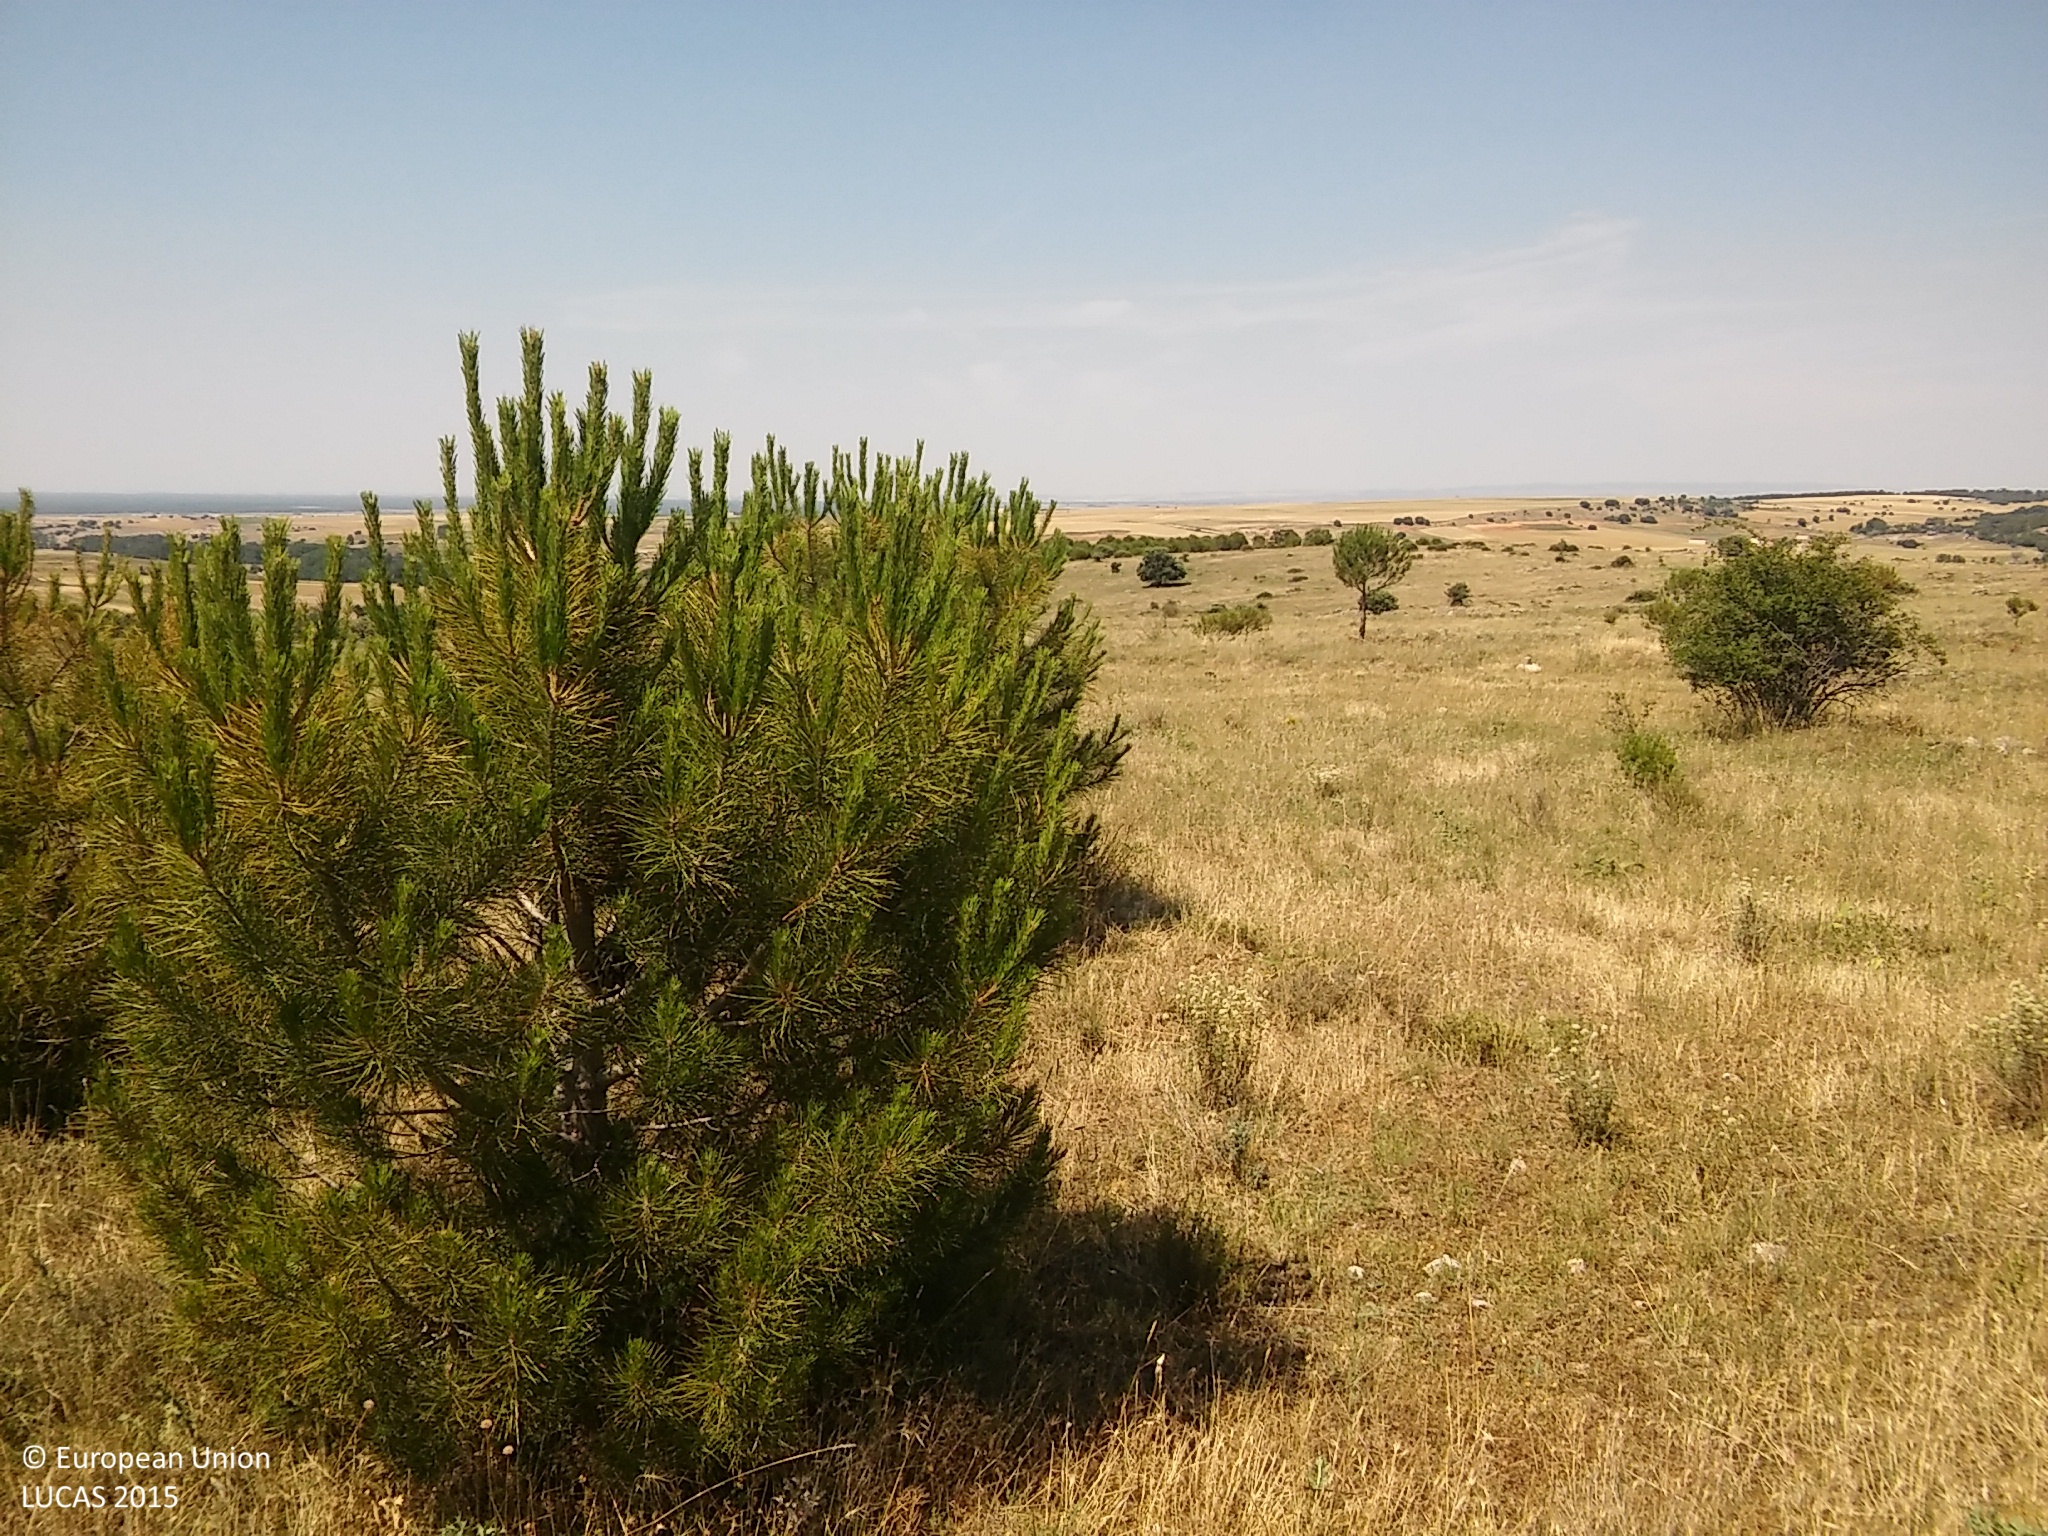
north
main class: Woodland
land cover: Pine dominated coniferous woodland
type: coniferous forest of the mediterranean region
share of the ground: 10 - 25 %
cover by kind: herbaceous plants 65 %, shrubs 25 %, coniferous forest trees 10 %
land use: Forestry
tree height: < 5 m
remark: Nursery
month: June
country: ES
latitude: 41.1128
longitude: -3.9716
